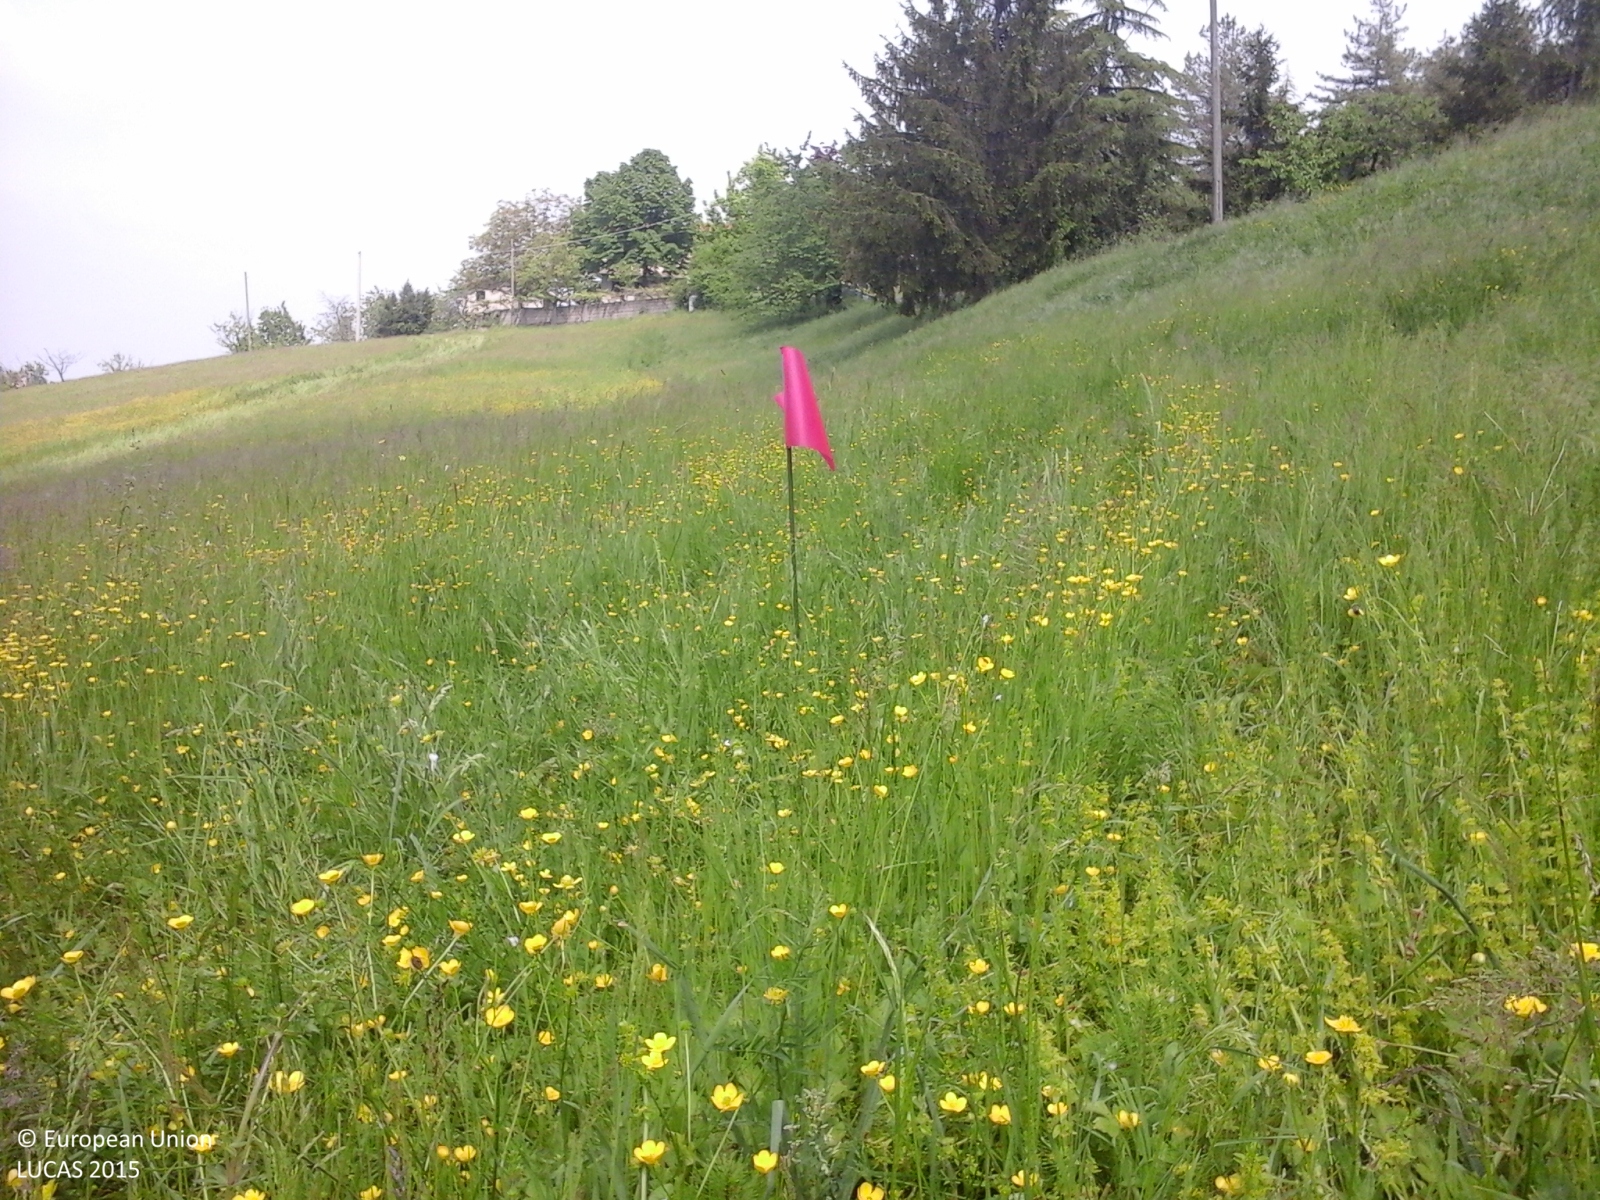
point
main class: Grassland
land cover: Grassland without tree/shrub cover
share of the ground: > 75 %
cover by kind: herbaceous plants 100 %
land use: Agriculture (excluding fallow land and kitchen gardens)
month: May
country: IT
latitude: 44.4522
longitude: 11.1661
